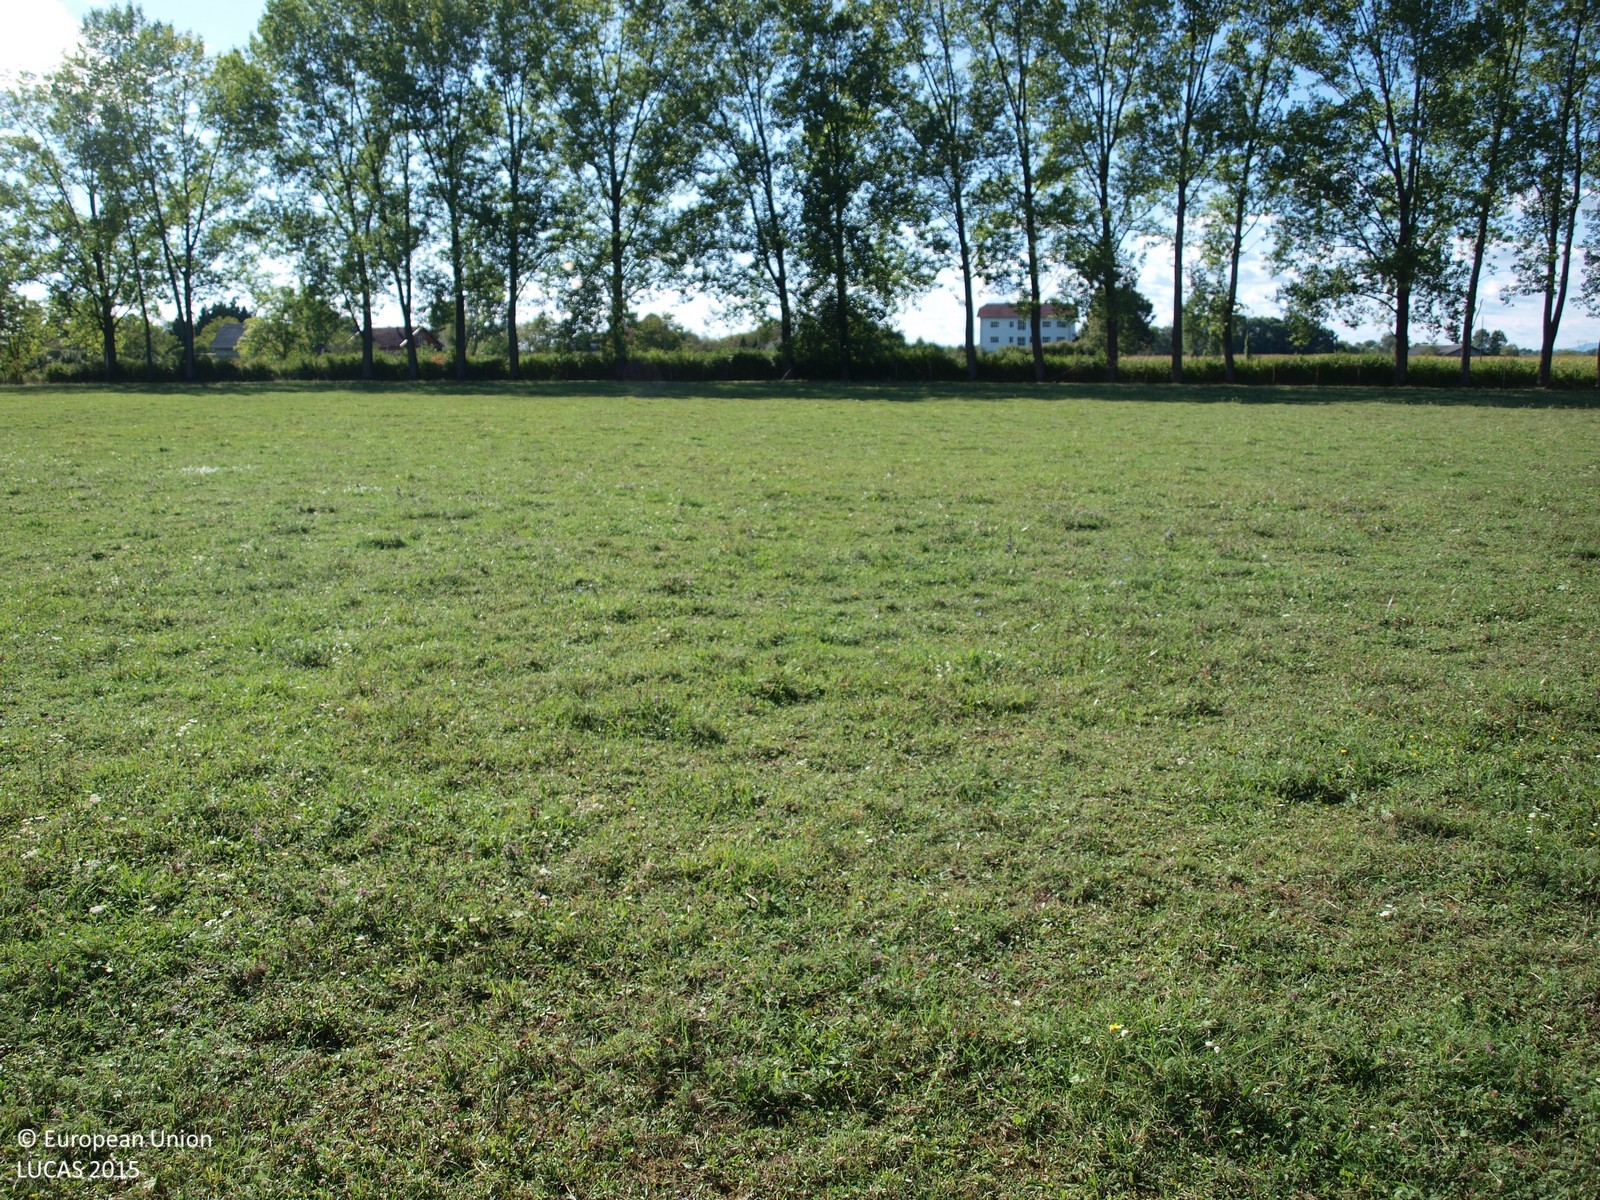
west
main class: Grassland
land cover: Grassland without tree/shrub cover
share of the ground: > 75 %
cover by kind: herbaceous plants 100 %
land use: Agriculture (excluding fallow land and kitchen gardens)
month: September
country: HR
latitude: 45.6565
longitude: 16.3508
